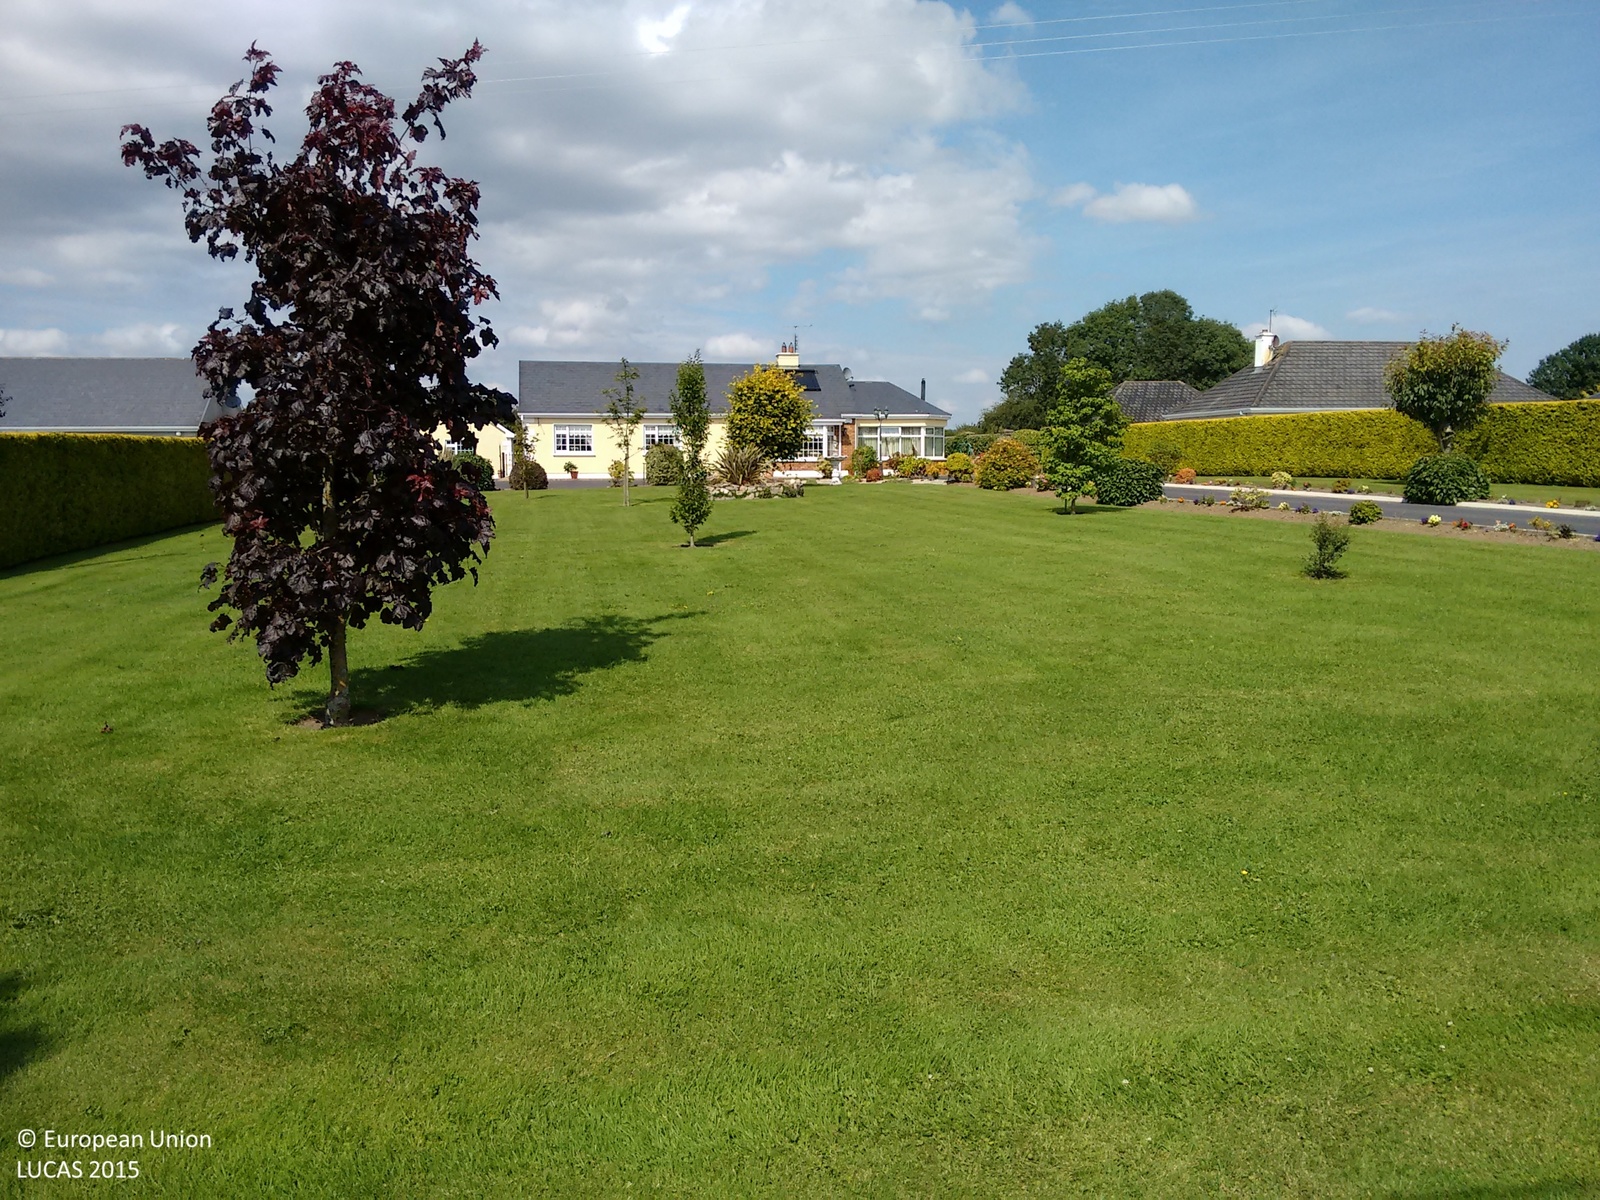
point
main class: Grassland
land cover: Grassland with sparse tree/shrub cover
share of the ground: > 75 %
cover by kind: herbaceous plants 90 %, broadleaved forest trees 5 %, shrubs 5 %
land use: Residential
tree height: < 5 m
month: August
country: IE
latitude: 52.9990
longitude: -7.4872
